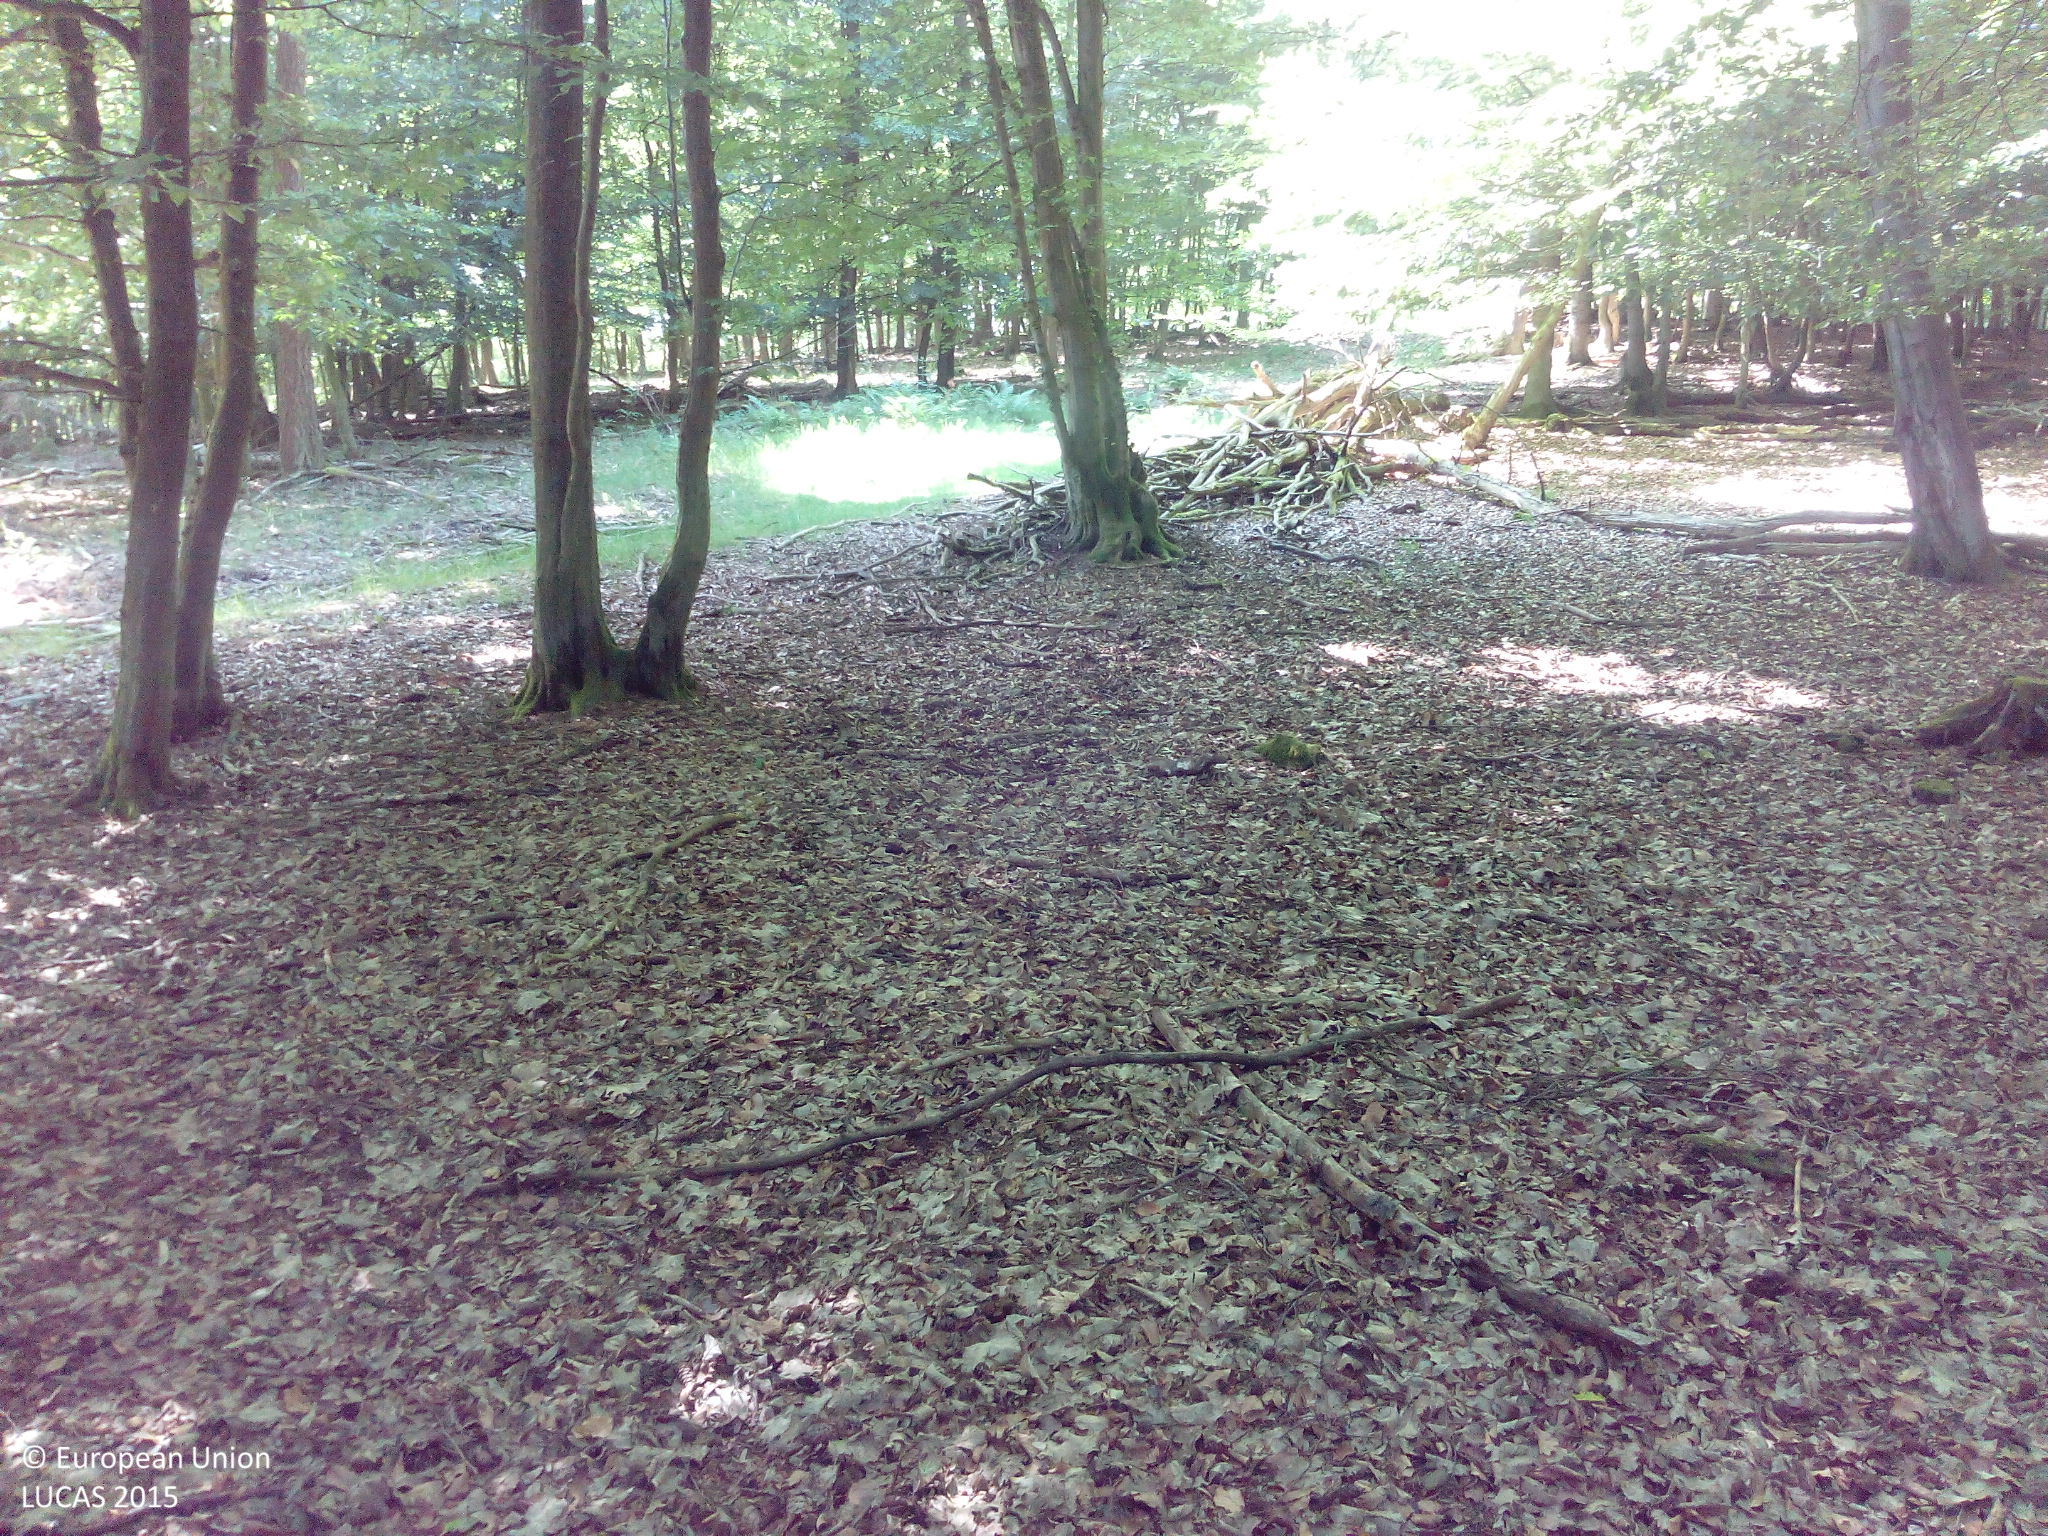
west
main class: Woodland
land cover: Broadleaved woodland
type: mesophytic deciduous forest
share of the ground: > 75 %
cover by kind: broadleaved forest trees 90 %, unconsolidated bare surface 10 %
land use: Forestry
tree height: > 5 m
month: June
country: DE
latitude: 50.1851
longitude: 8.0257
